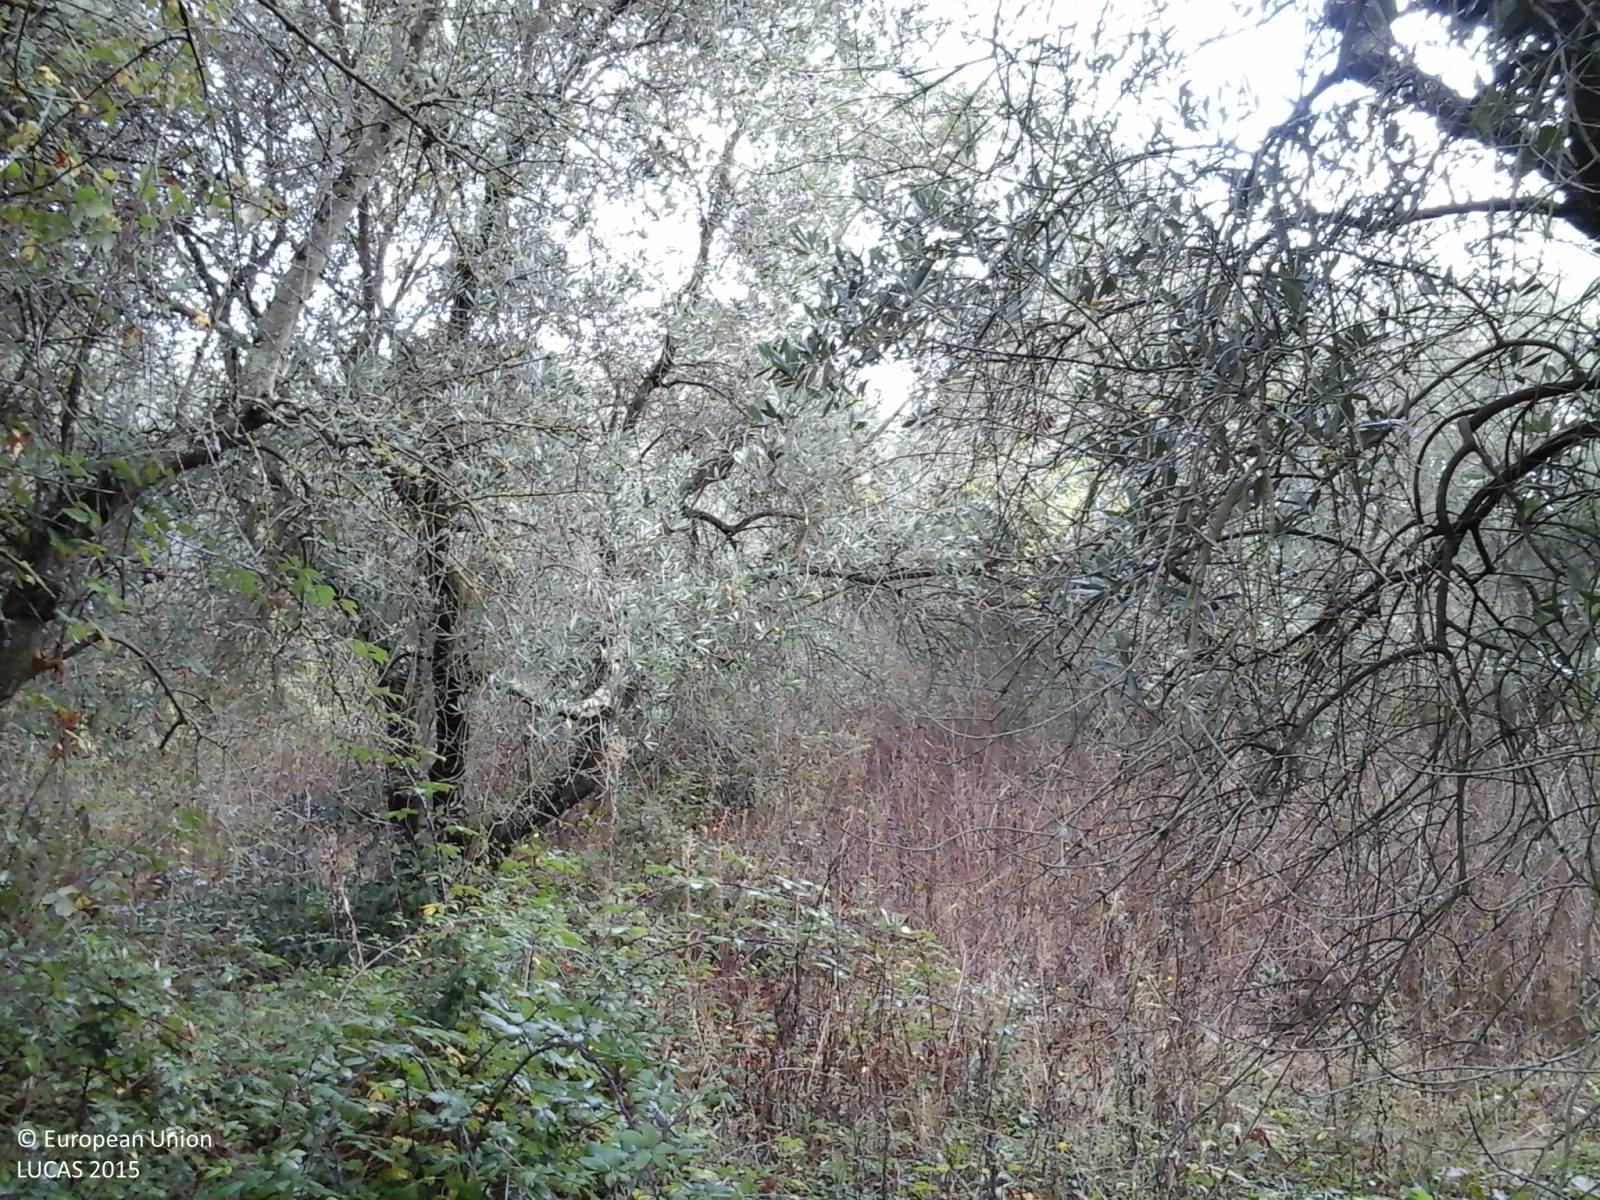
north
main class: Cropland
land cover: Olive groves
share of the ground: 50 - 75 %
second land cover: Shrubland without tree cover
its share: > 75 %
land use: Abandoned areas
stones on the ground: 10 - 25 %
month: October
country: IT
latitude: 43.0652
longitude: 10.9181
